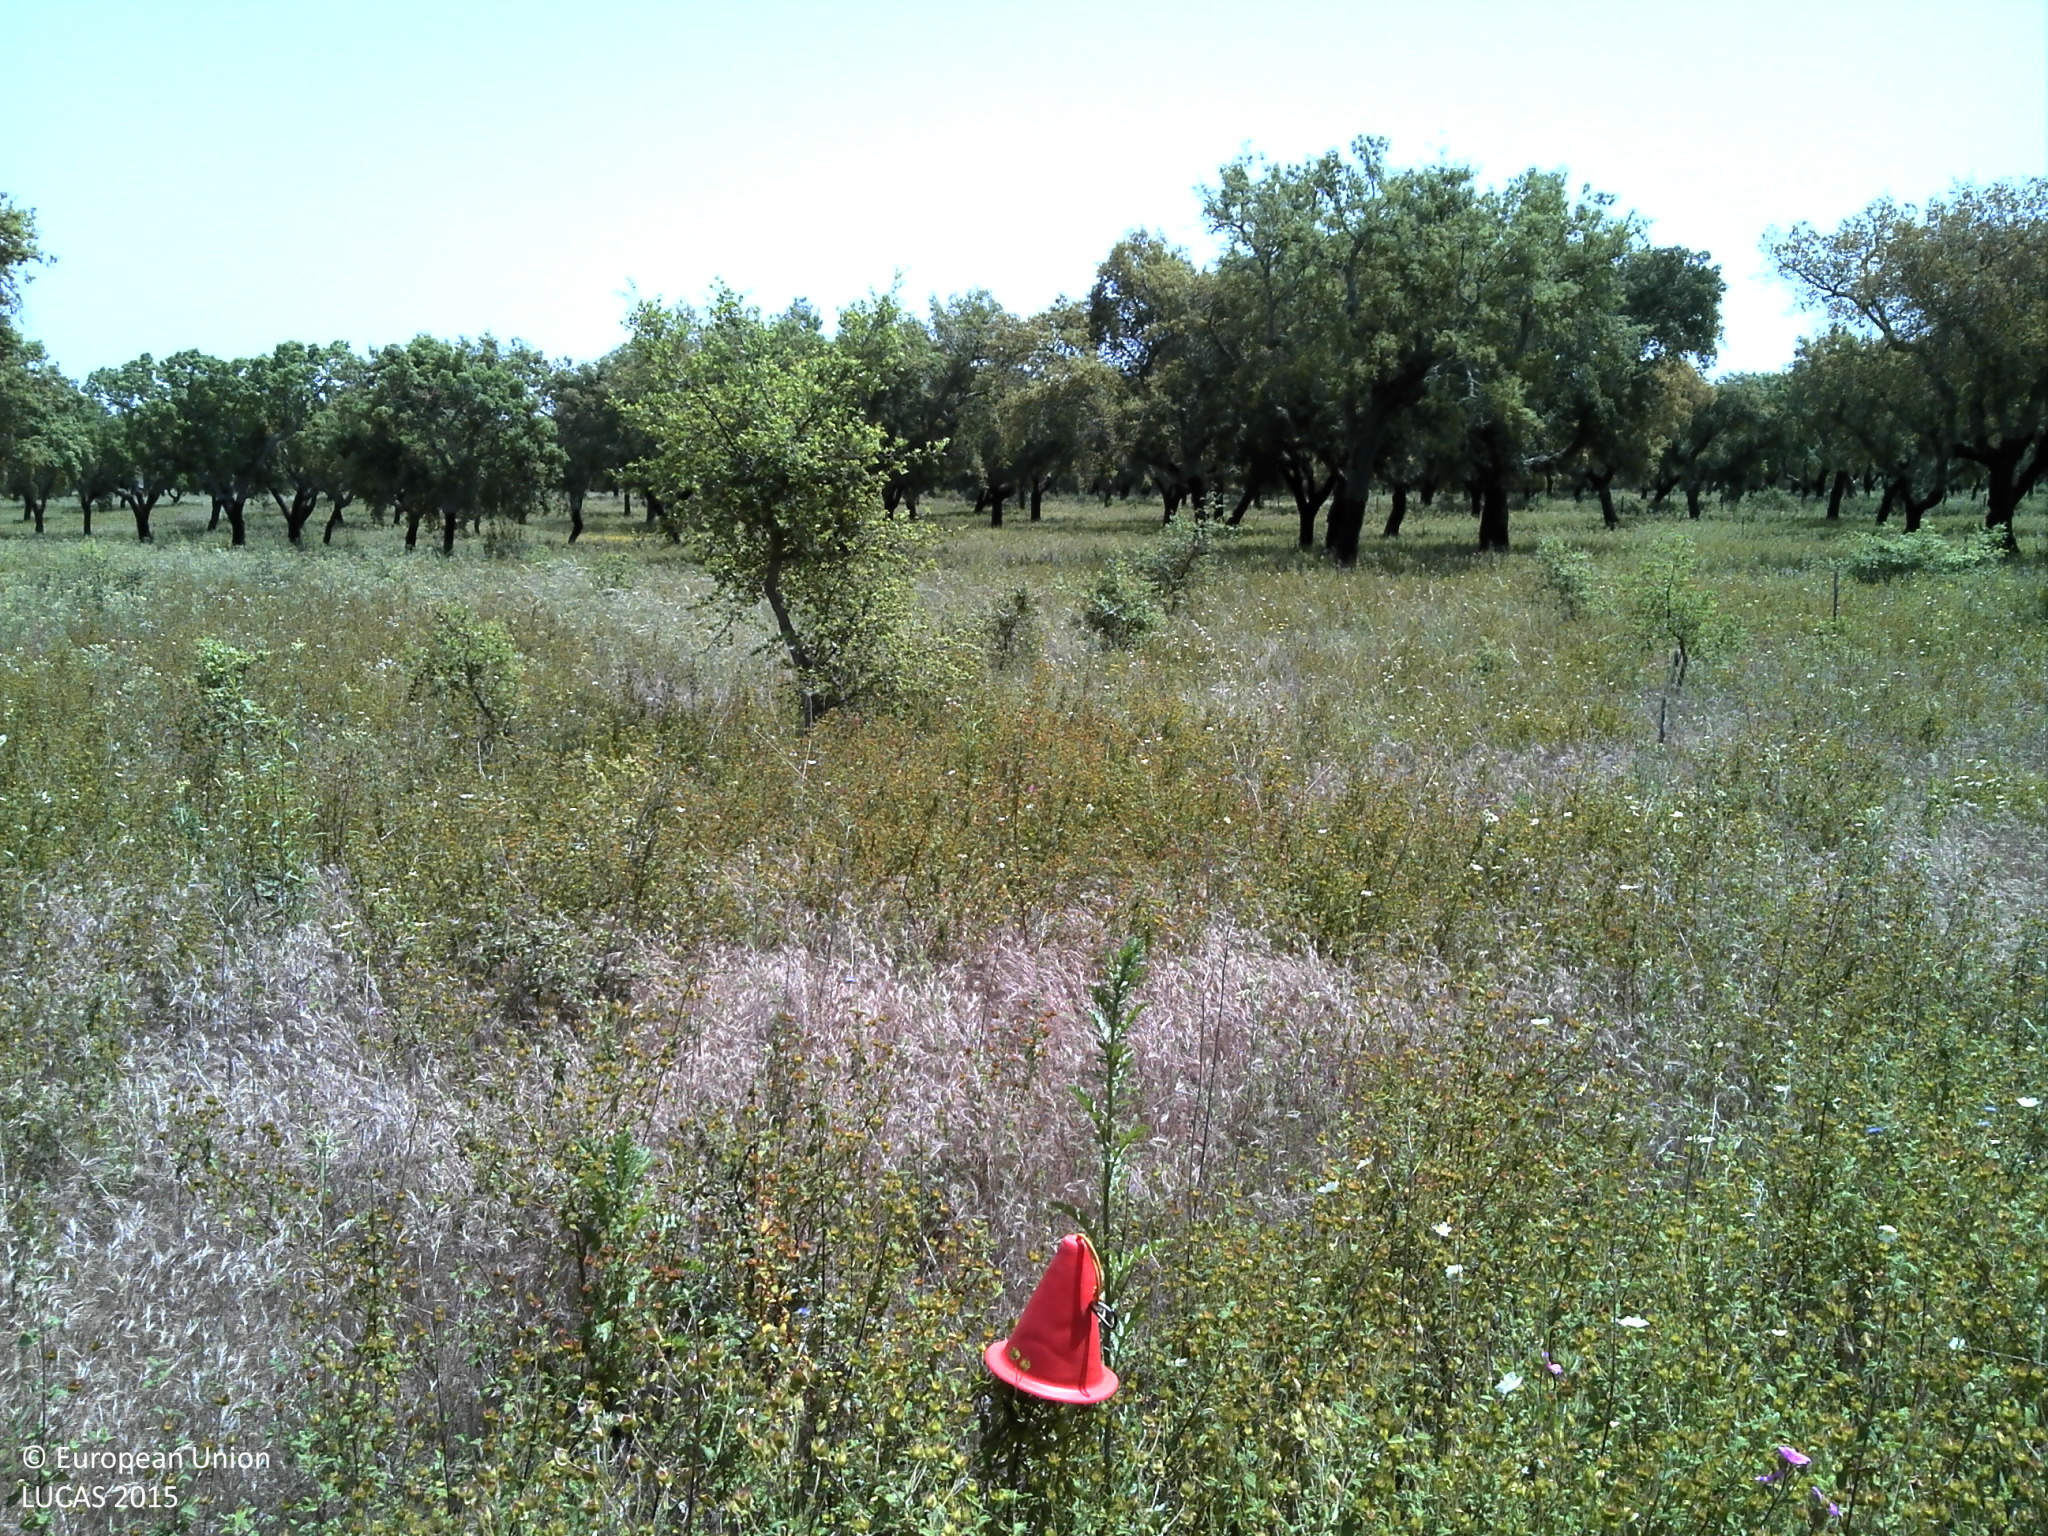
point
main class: Woodland
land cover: Broadleaved woodland
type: broadleaved evergreen forest
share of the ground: 10 - 25 %
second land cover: Grassland without tree/shrub cover
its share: 50 - 75 %
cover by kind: herbaceous plants 75 %, broadleaved forest trees 15 %, unconsolidated bare surface 10 %
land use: Forestry
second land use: Agriculture (excluding fallow land and kitchen gardens)
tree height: > 5 m
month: May
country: PT
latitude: 38.9833
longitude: -7.8584
